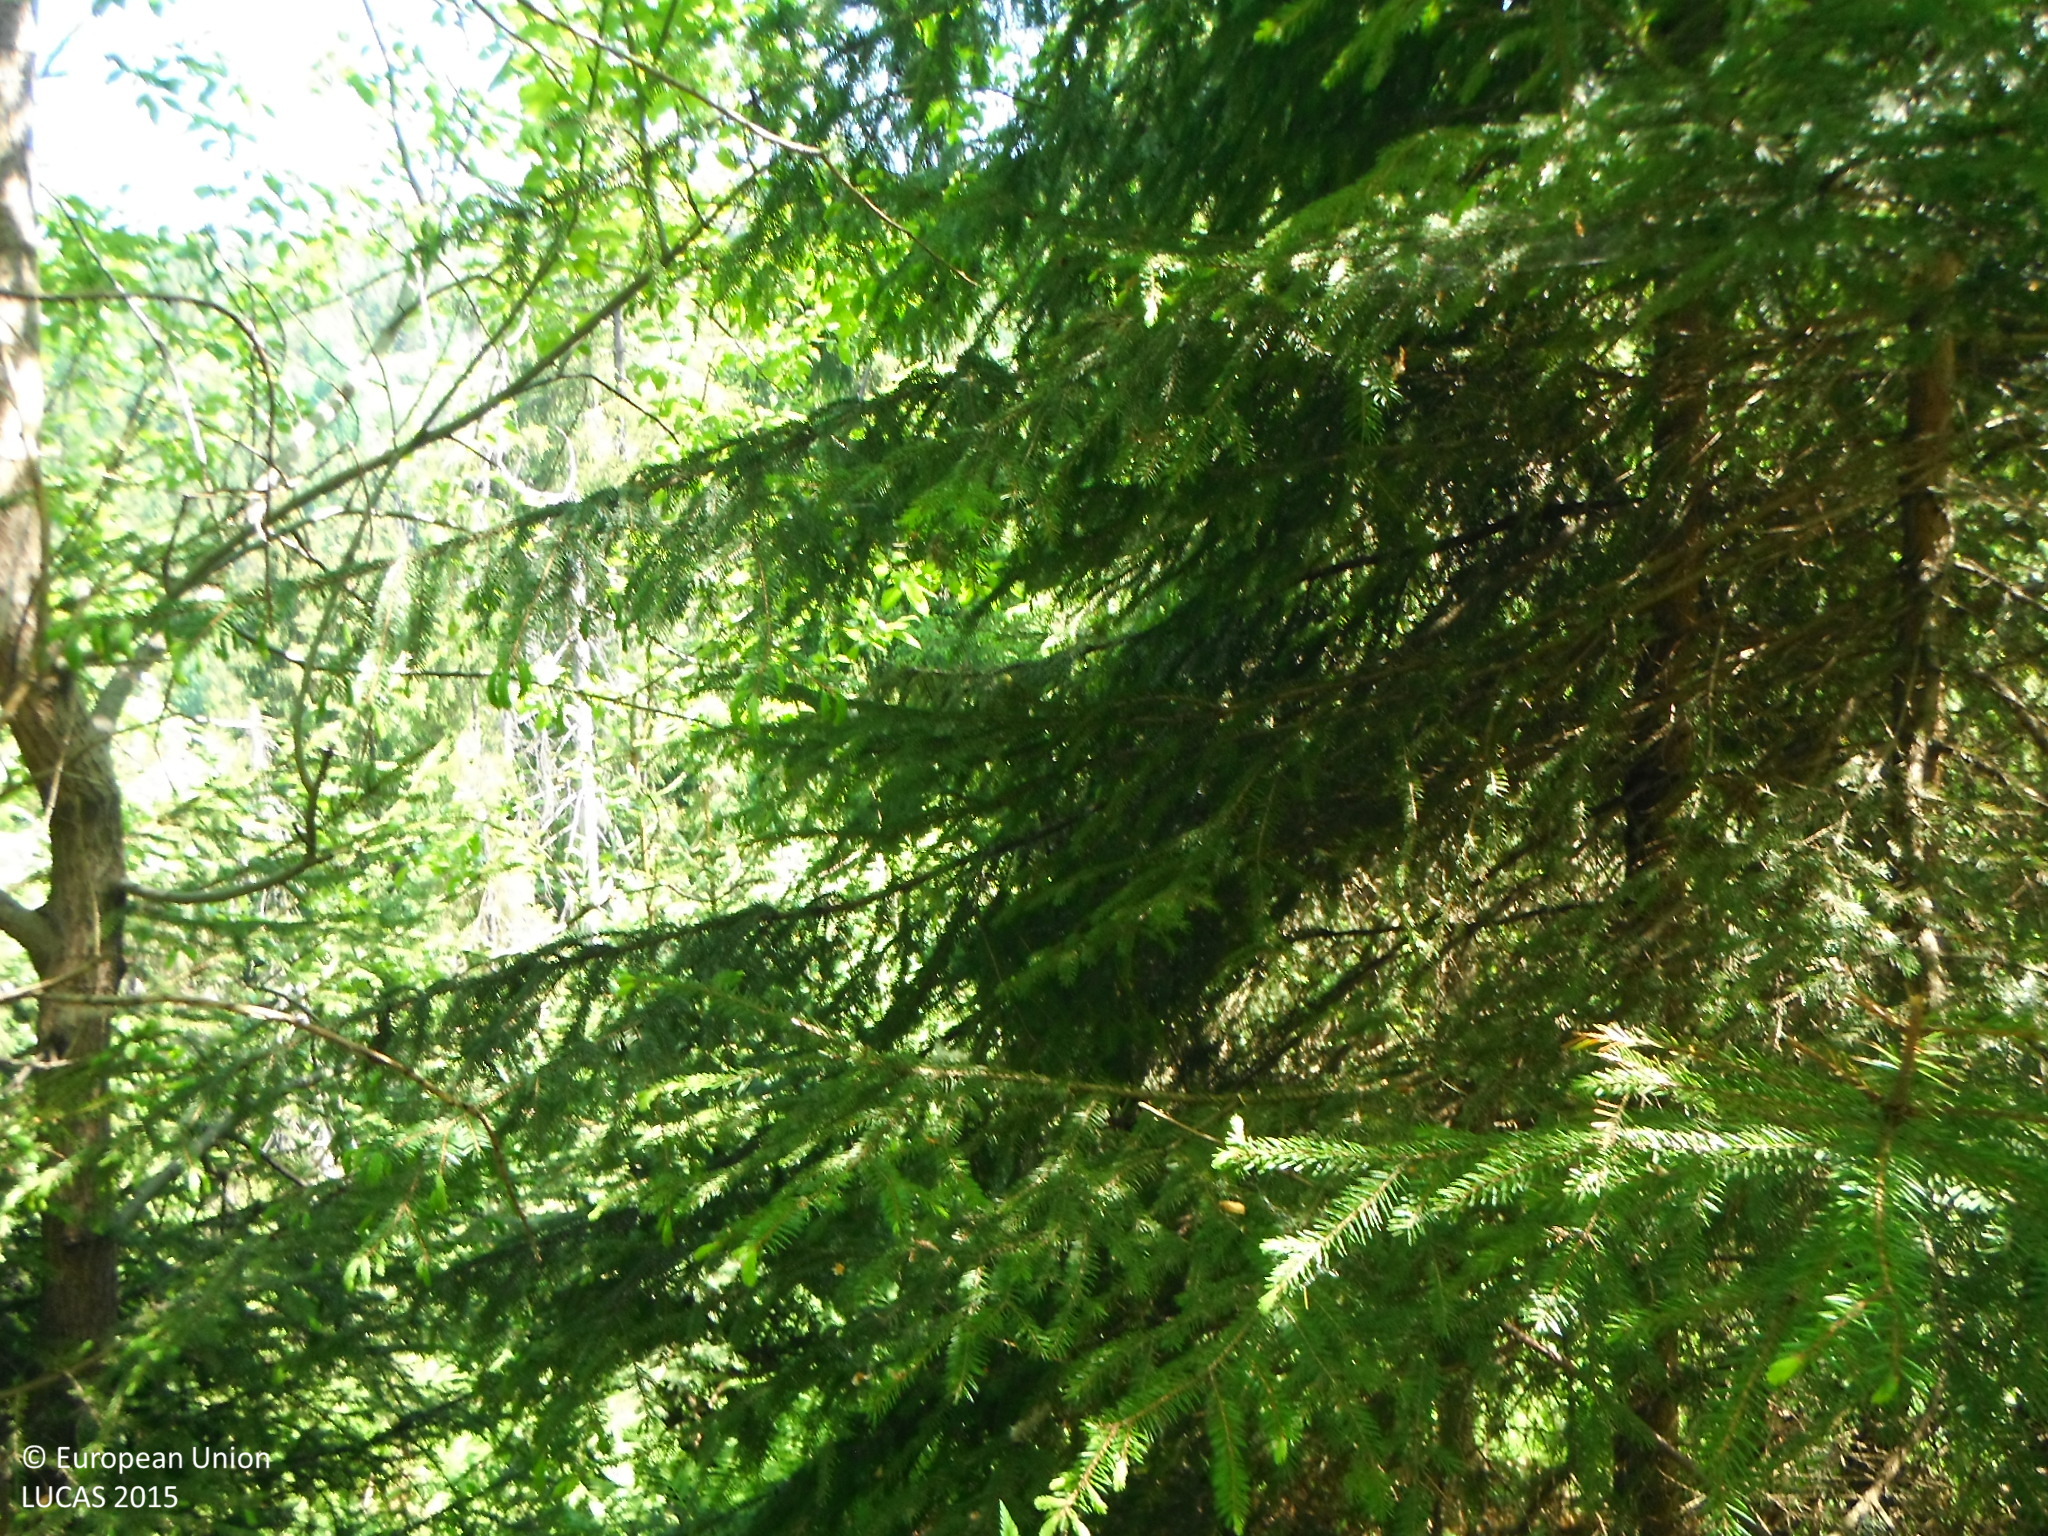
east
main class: Woodland
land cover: Other mixed woodland
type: hemiboreal forest and nemoral coniferous forest and mixed broadleaved-coniferous forest
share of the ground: > 75 %
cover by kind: coniferous forest trees 60 %, broadleaved forest trees 40 %
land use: Forestry
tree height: > 5 m
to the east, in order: Other mixed woodland; Spruce dominated mixed woodland; Spontaneously vegetated surfaces; Ditches and canals; Spruce dominated mixed woodland; Spontaneously vegetated surfaces; Paved roads, cycling and walking lanes; Grass margins; Ditches and canals; Grassland without tree/shrub cover; Spruce dominated coniferous woodland
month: June
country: SK
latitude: 49.3216
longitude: 20.2561
